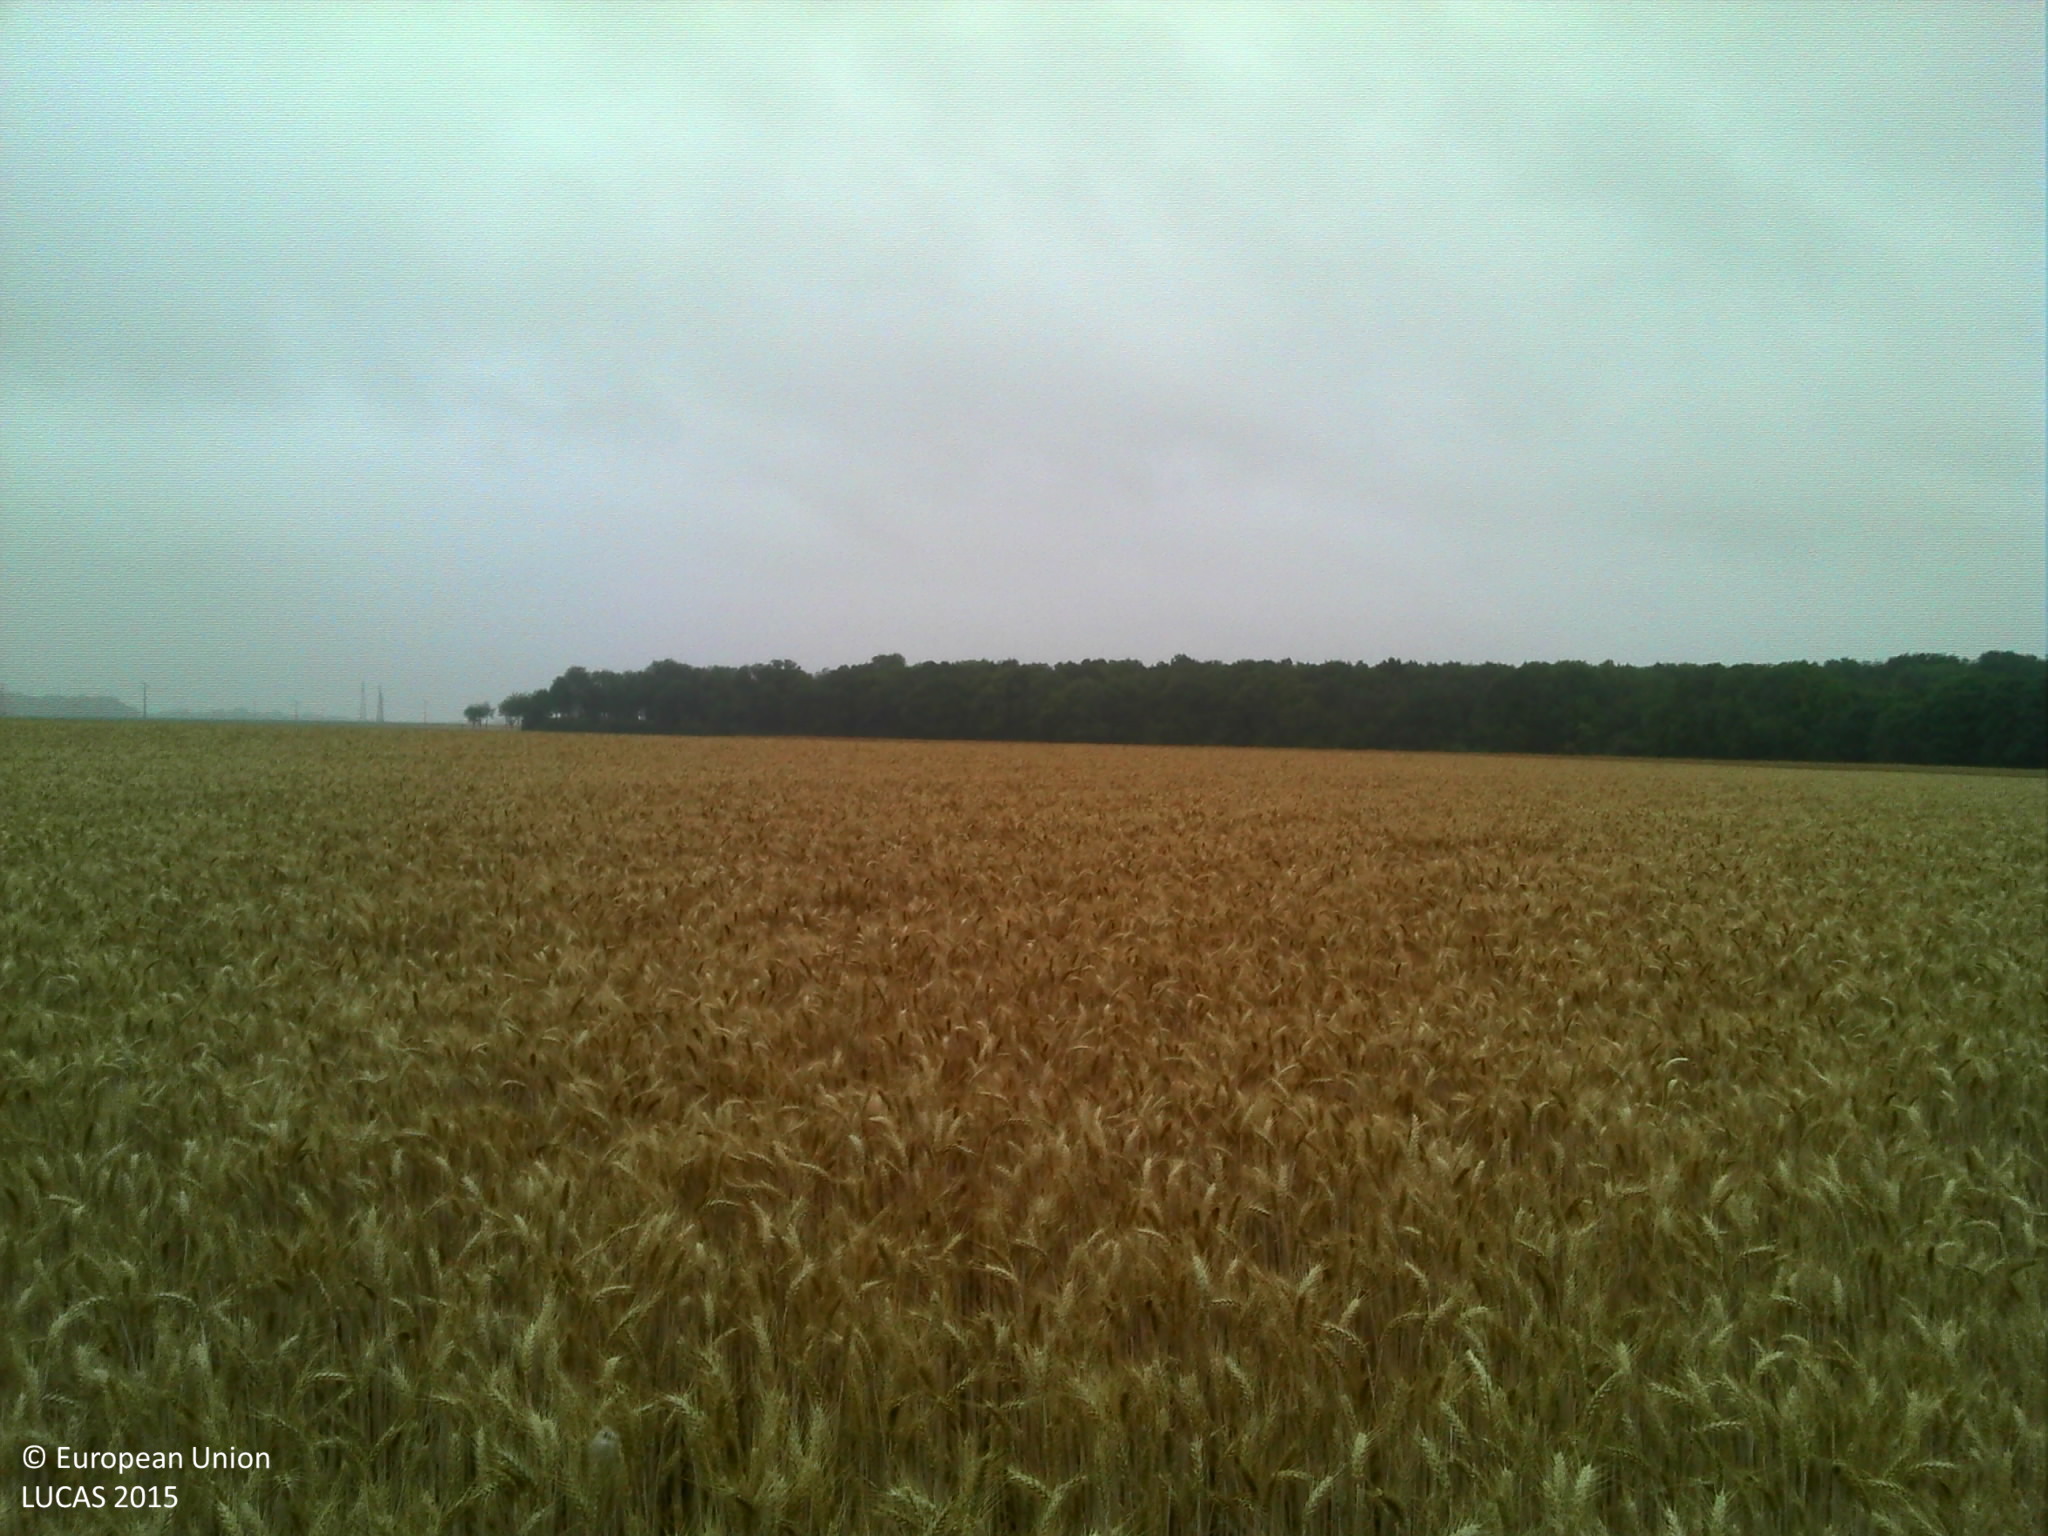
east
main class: Cropland
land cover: Common wheat
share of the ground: > 75 %
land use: Agriculture (excluding fallow land and kitchen gardens)
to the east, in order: Common wheat; Rape and turnip rape
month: July
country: FR
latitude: 49.3327
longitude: 2.3776
